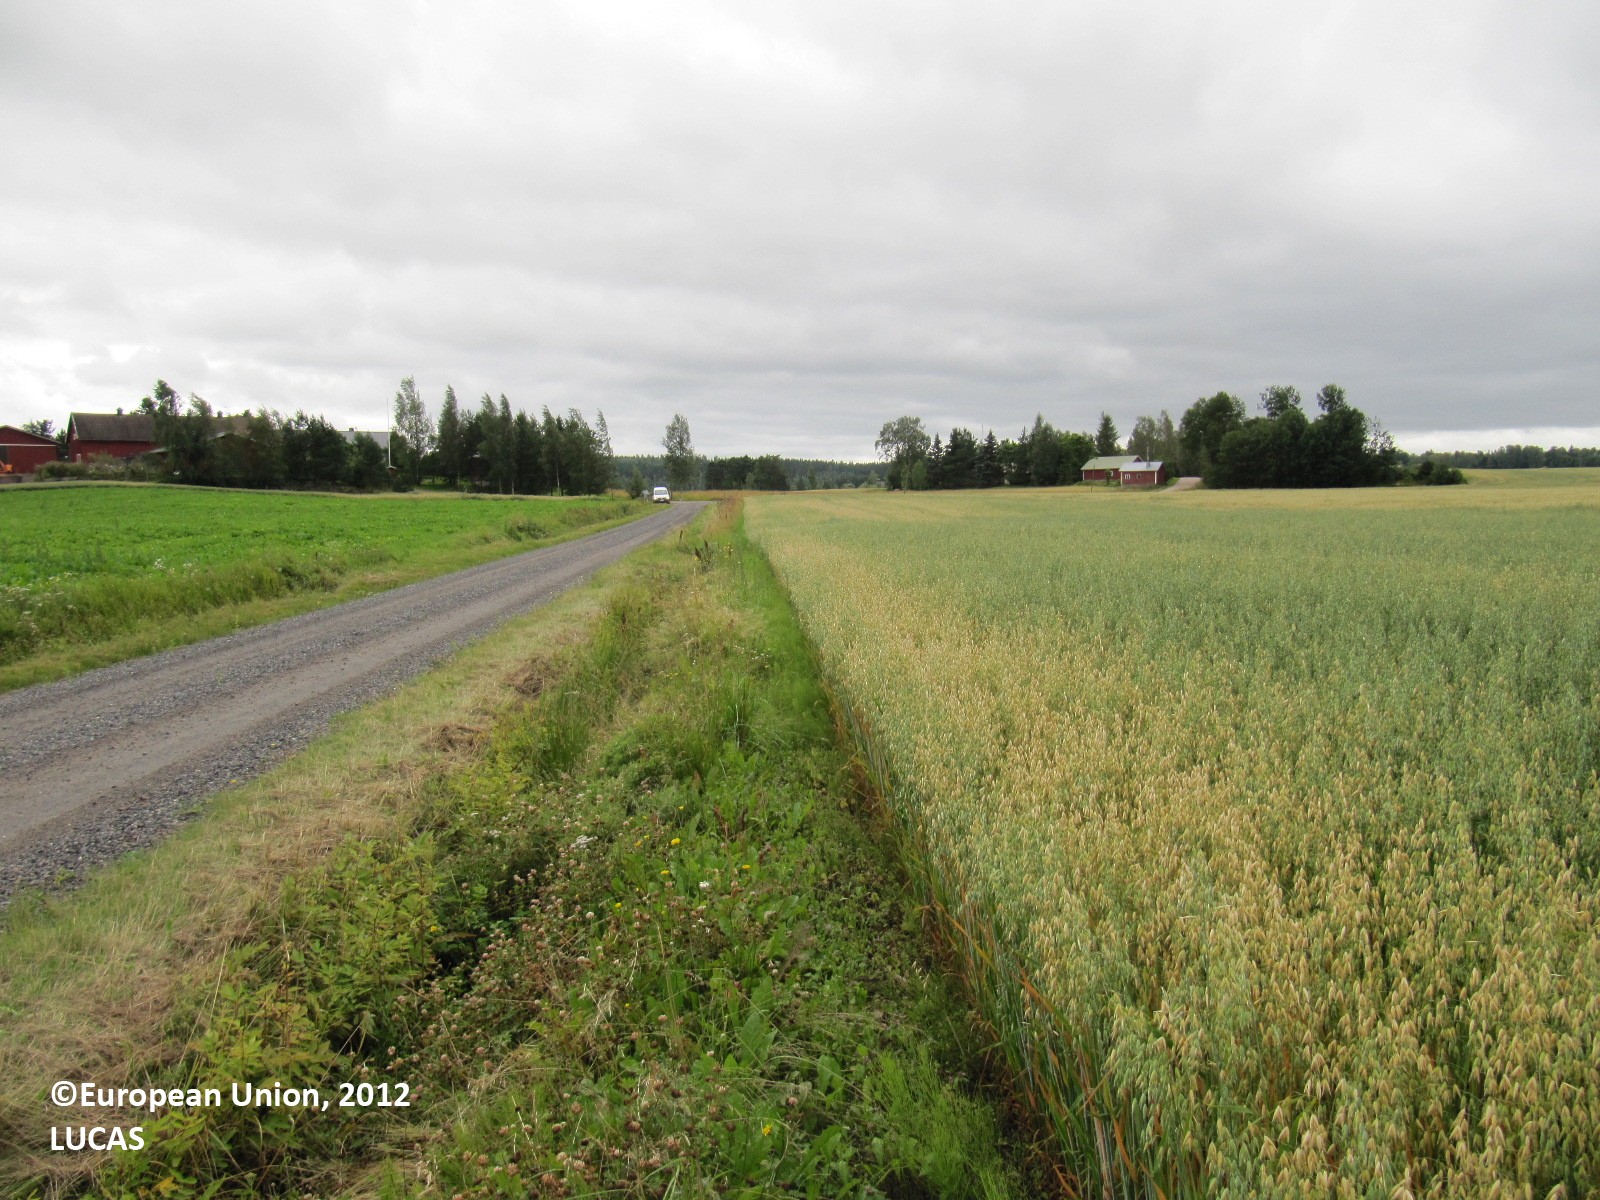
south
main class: Cropland
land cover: Oats
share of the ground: > 75 %
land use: Agriculture (excluding fallow land and kitchen gardens)
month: August
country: FI
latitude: 60.1785
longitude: 23.0059
